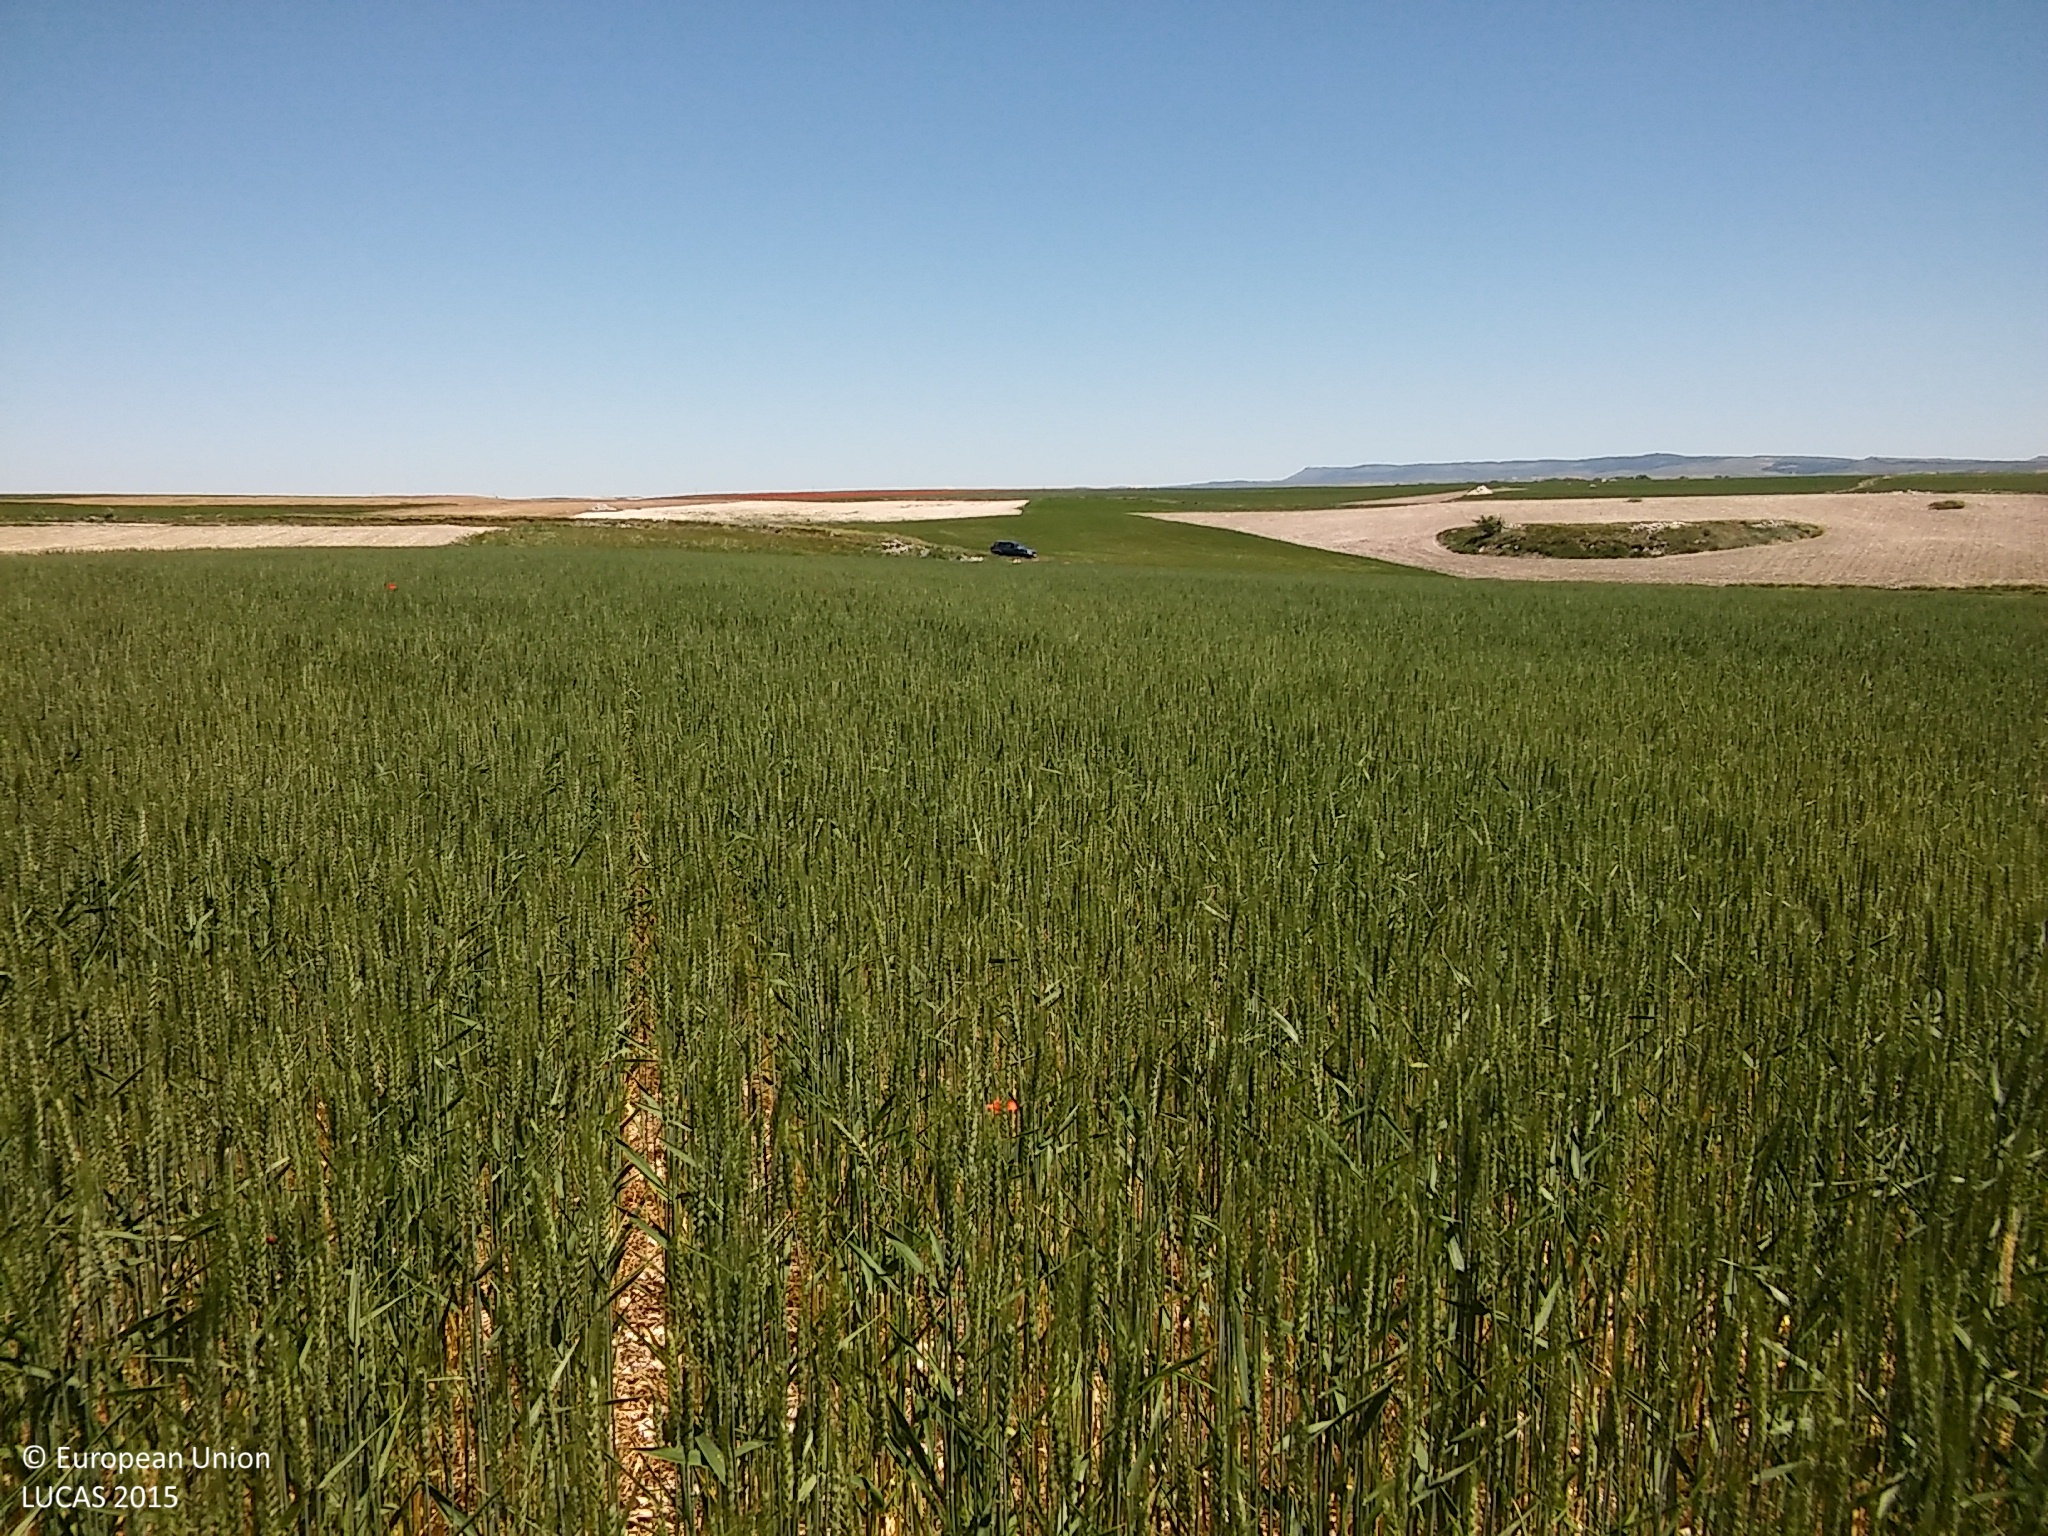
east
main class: Cropland
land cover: Common wheat
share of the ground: > 75 %
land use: Agriculture (excluding fallow land and kitchen gardens)
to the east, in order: Common wheat; Grassland without tree/shrub cover; Tracks; Grassland without tree/shrub cover; Barley
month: May
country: ES
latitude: 41.4708
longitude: -4.0292
